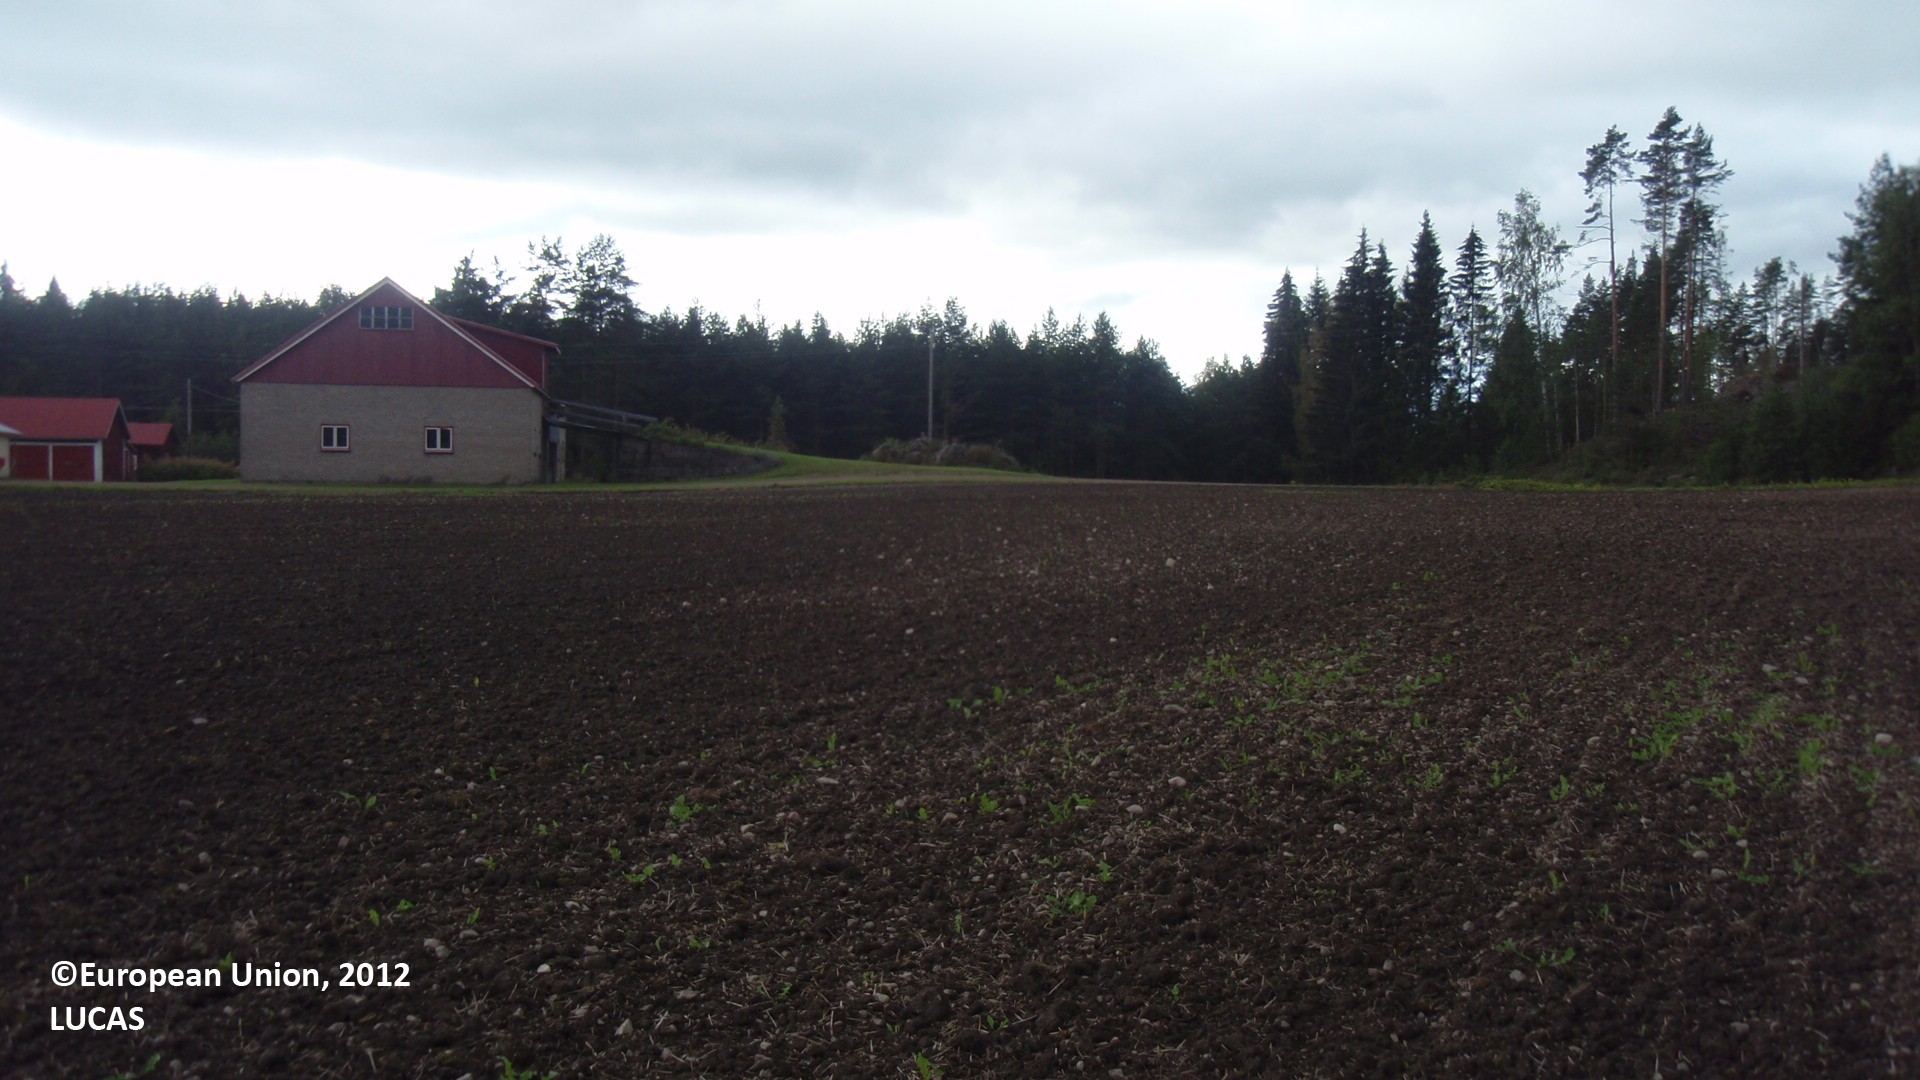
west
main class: Cropland
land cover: Oats
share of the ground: > 75 %
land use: Agriculture (excluding fallow land and kitchen gardens)
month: August
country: FI
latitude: 61.0115
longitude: 27.0946
